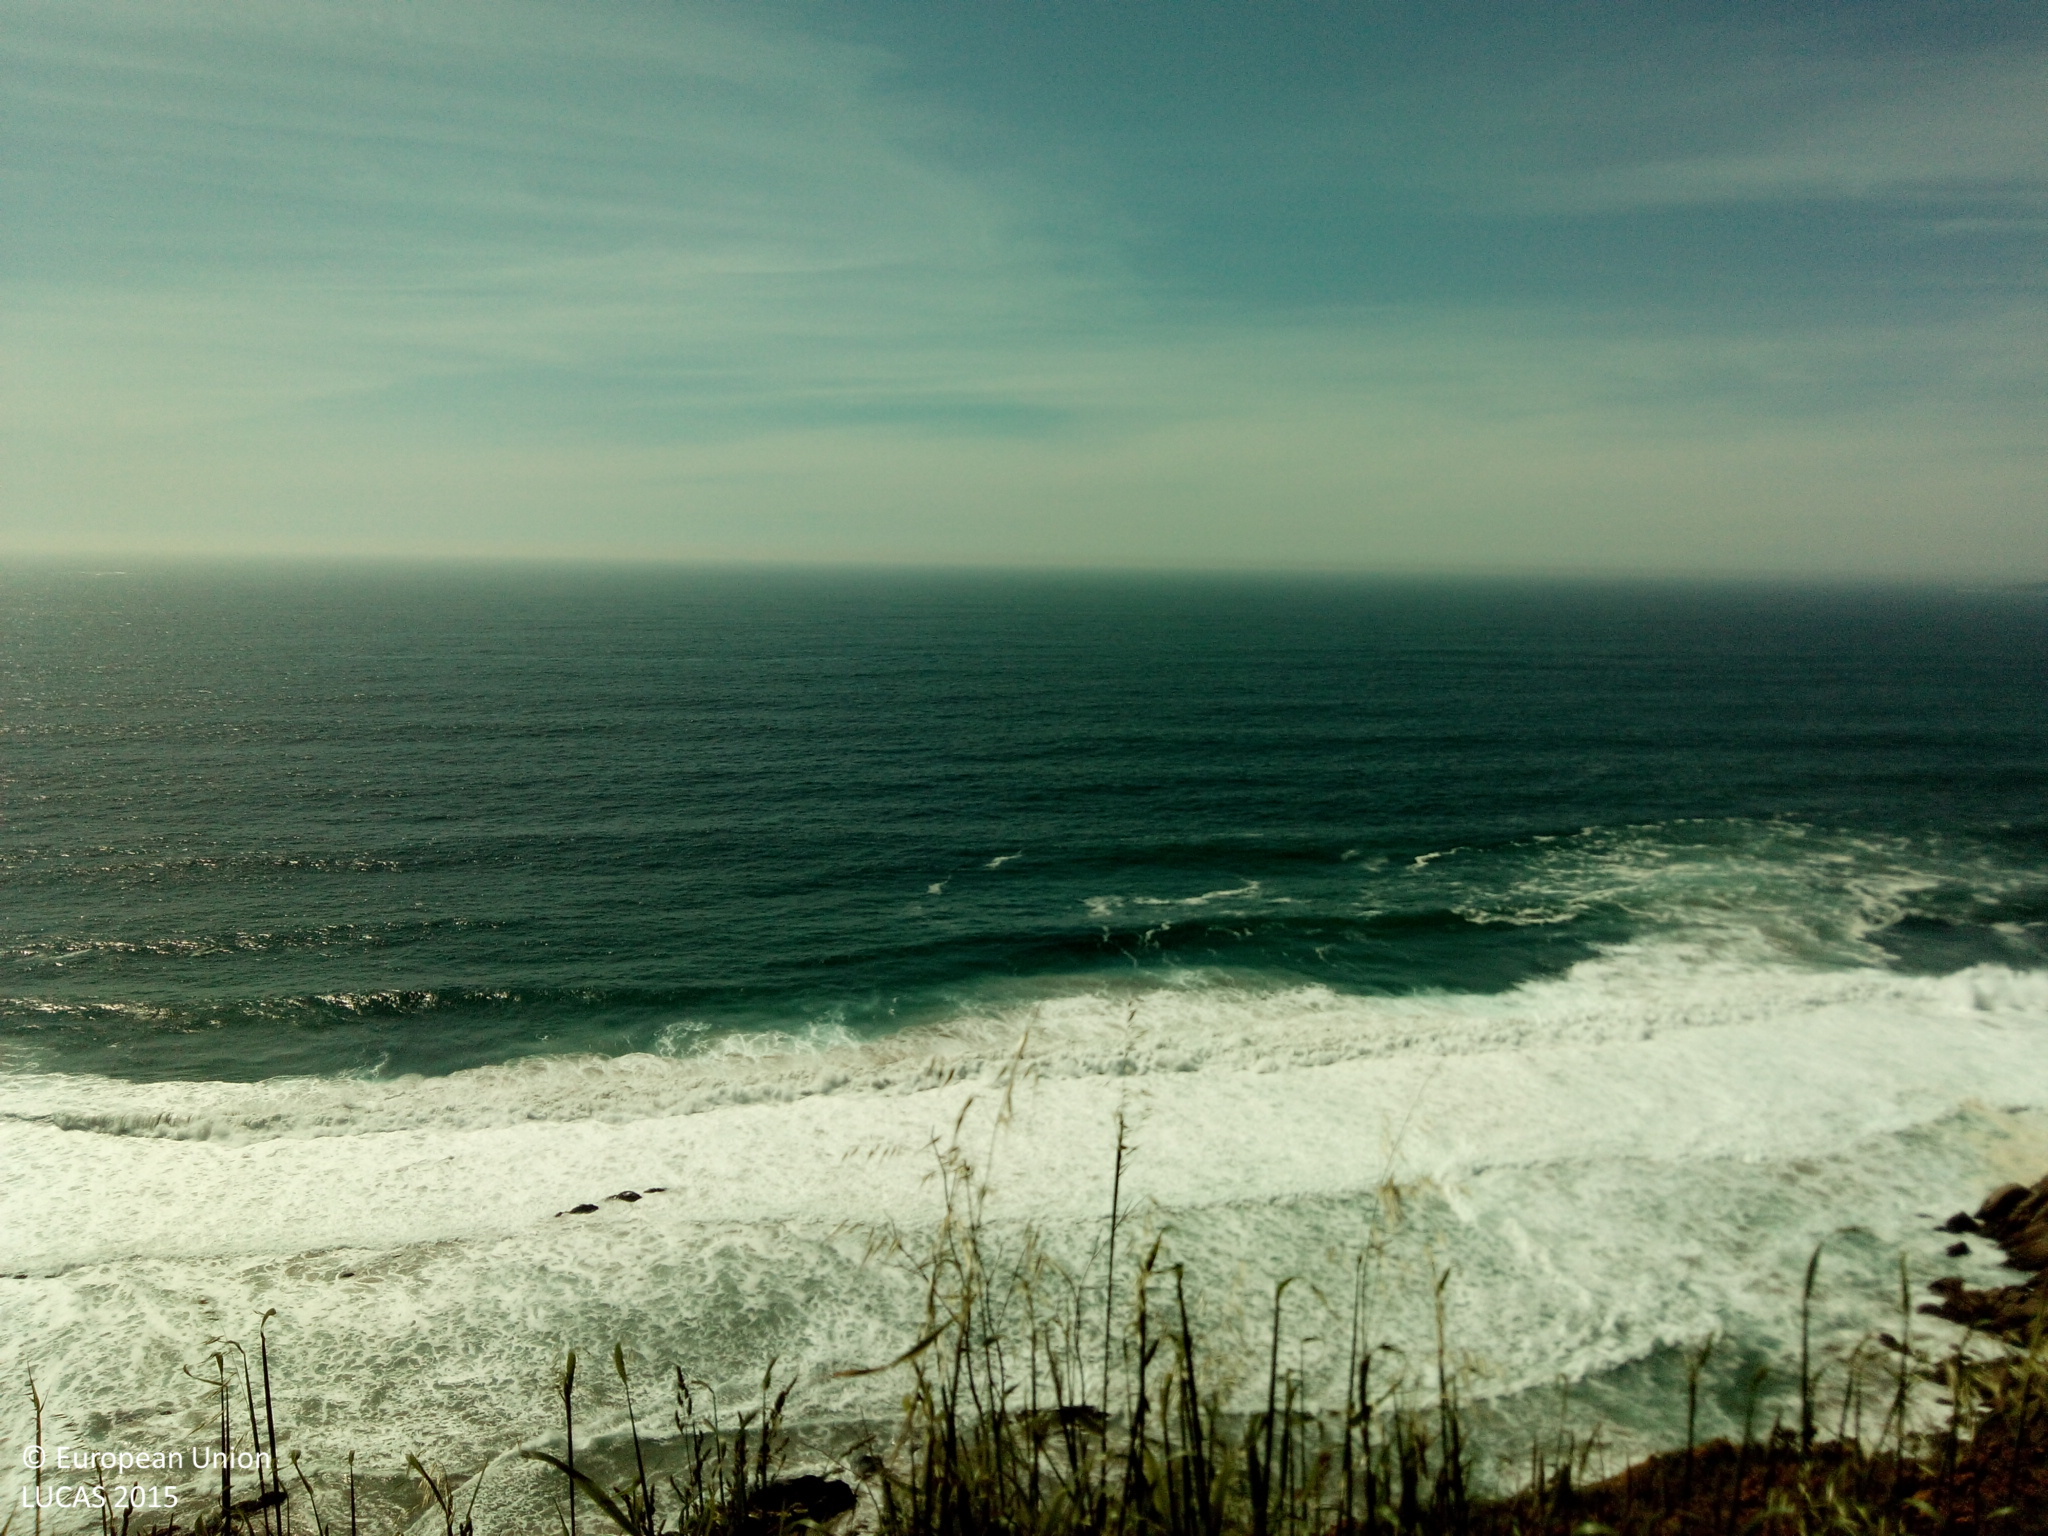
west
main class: Shrubland
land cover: Shrubland without tree cover
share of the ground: > 75 %
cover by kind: shrubs 75 %
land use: Semi-natural and natural areas not in use
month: May
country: ES
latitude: 42.2684
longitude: -8.8618
